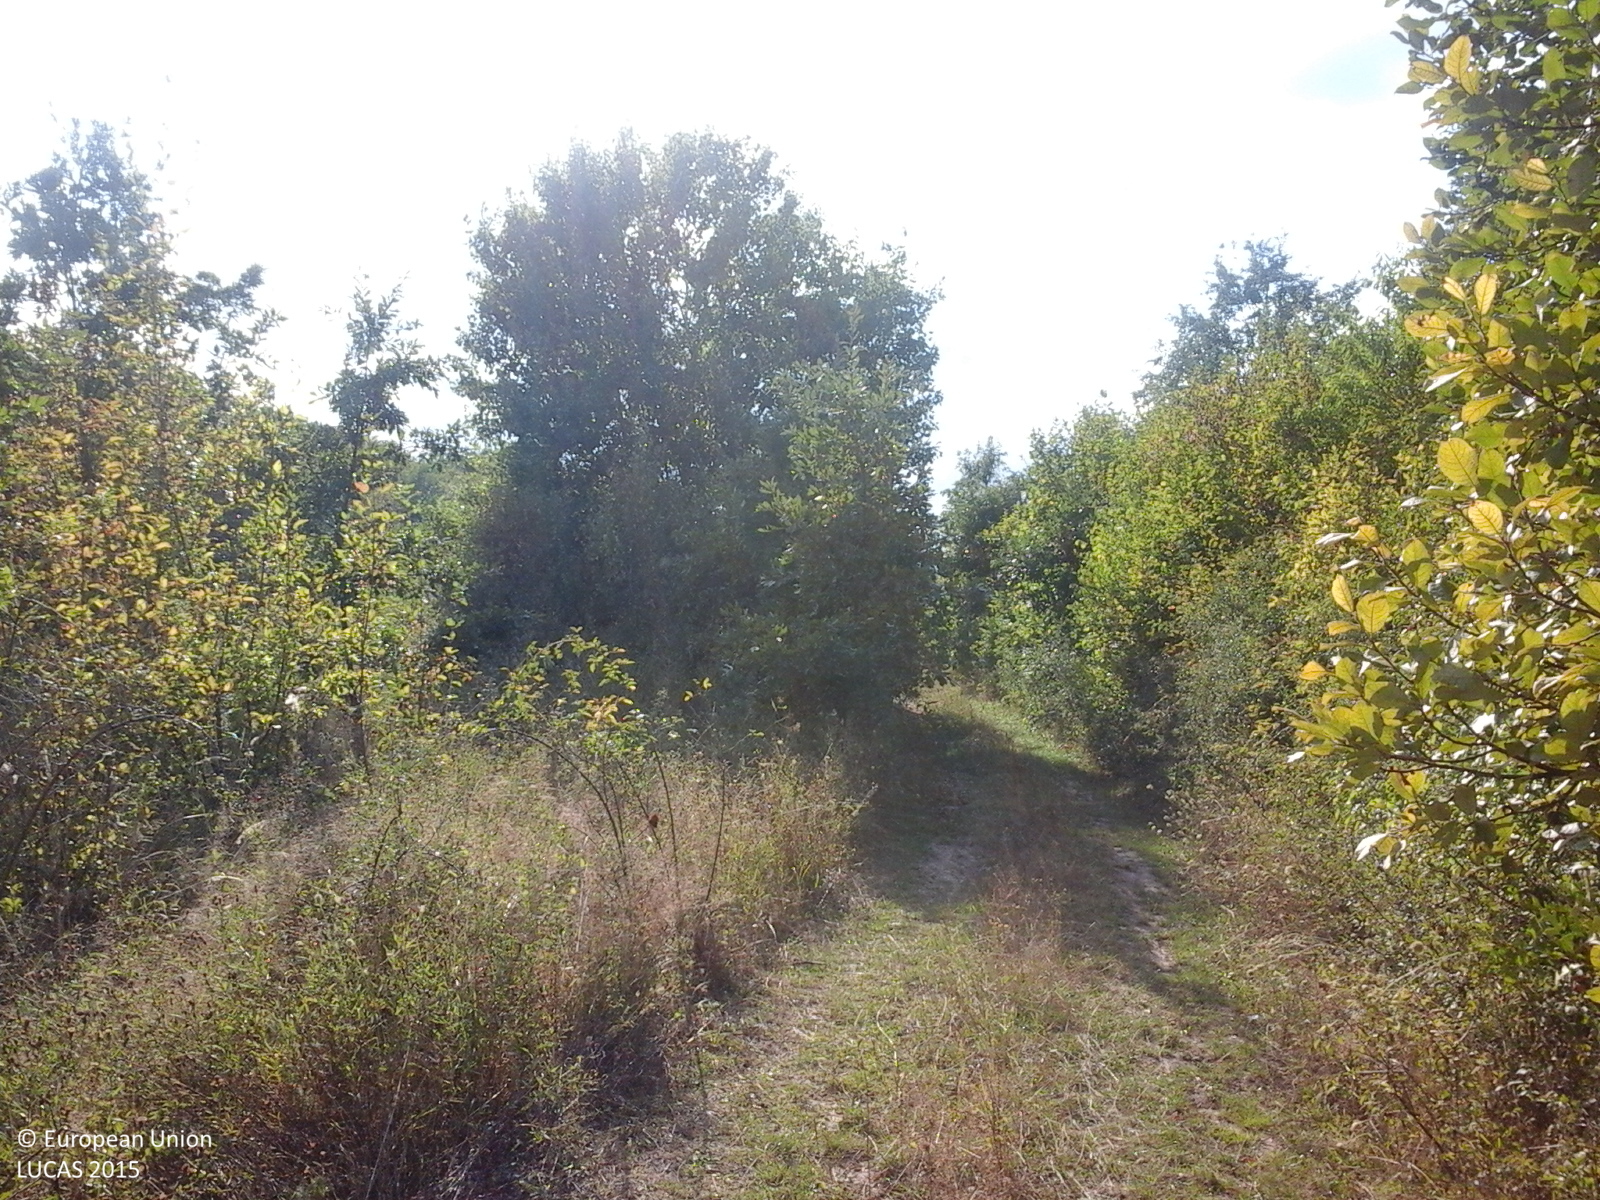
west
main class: Shrubland
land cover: Shrubland with sparse tree cover
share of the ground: > 75 %
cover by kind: shrubs 95 %, broadleaved forest trees 5 %
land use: Fallow land
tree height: > 5 m
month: September
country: RO
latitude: 47.3669
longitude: 23.0825
